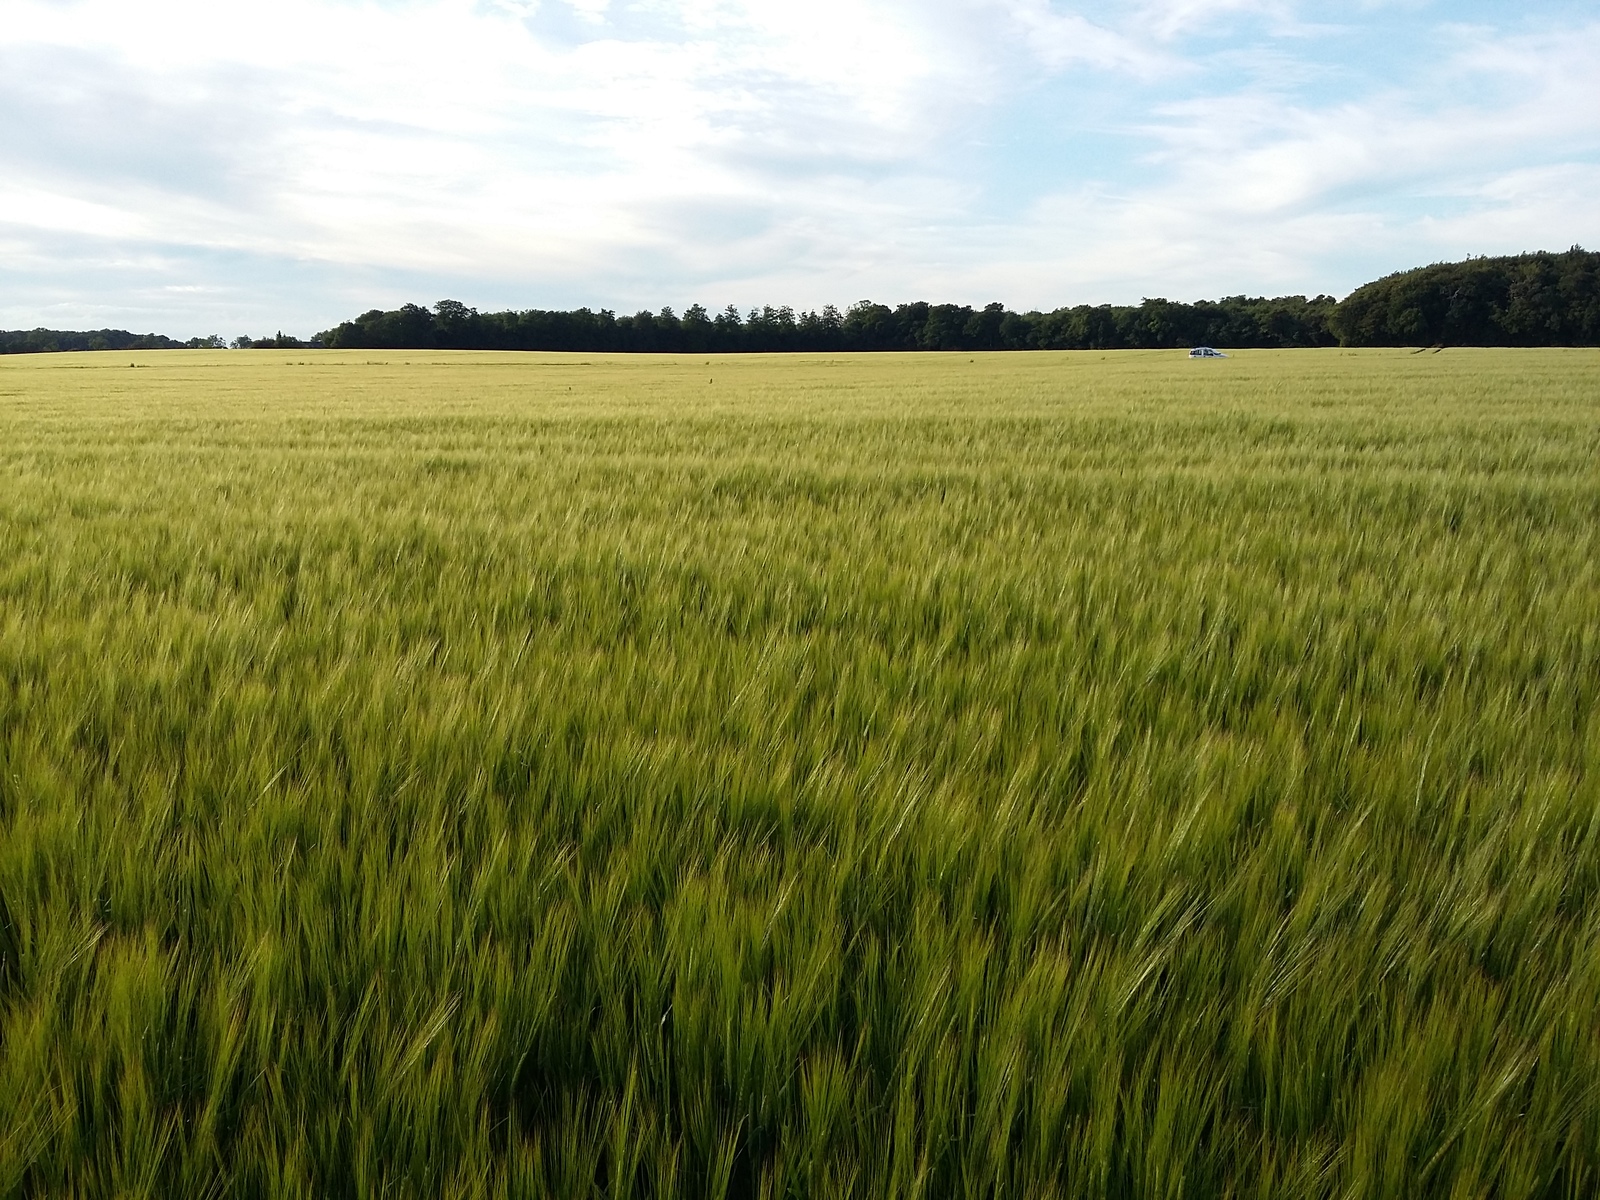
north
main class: Cropland
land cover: Barley
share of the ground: > 75 %
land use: Agriculture (excluding fallow land and kitchen gardens)
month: June
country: DK
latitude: 54.7697
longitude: 12.0039
